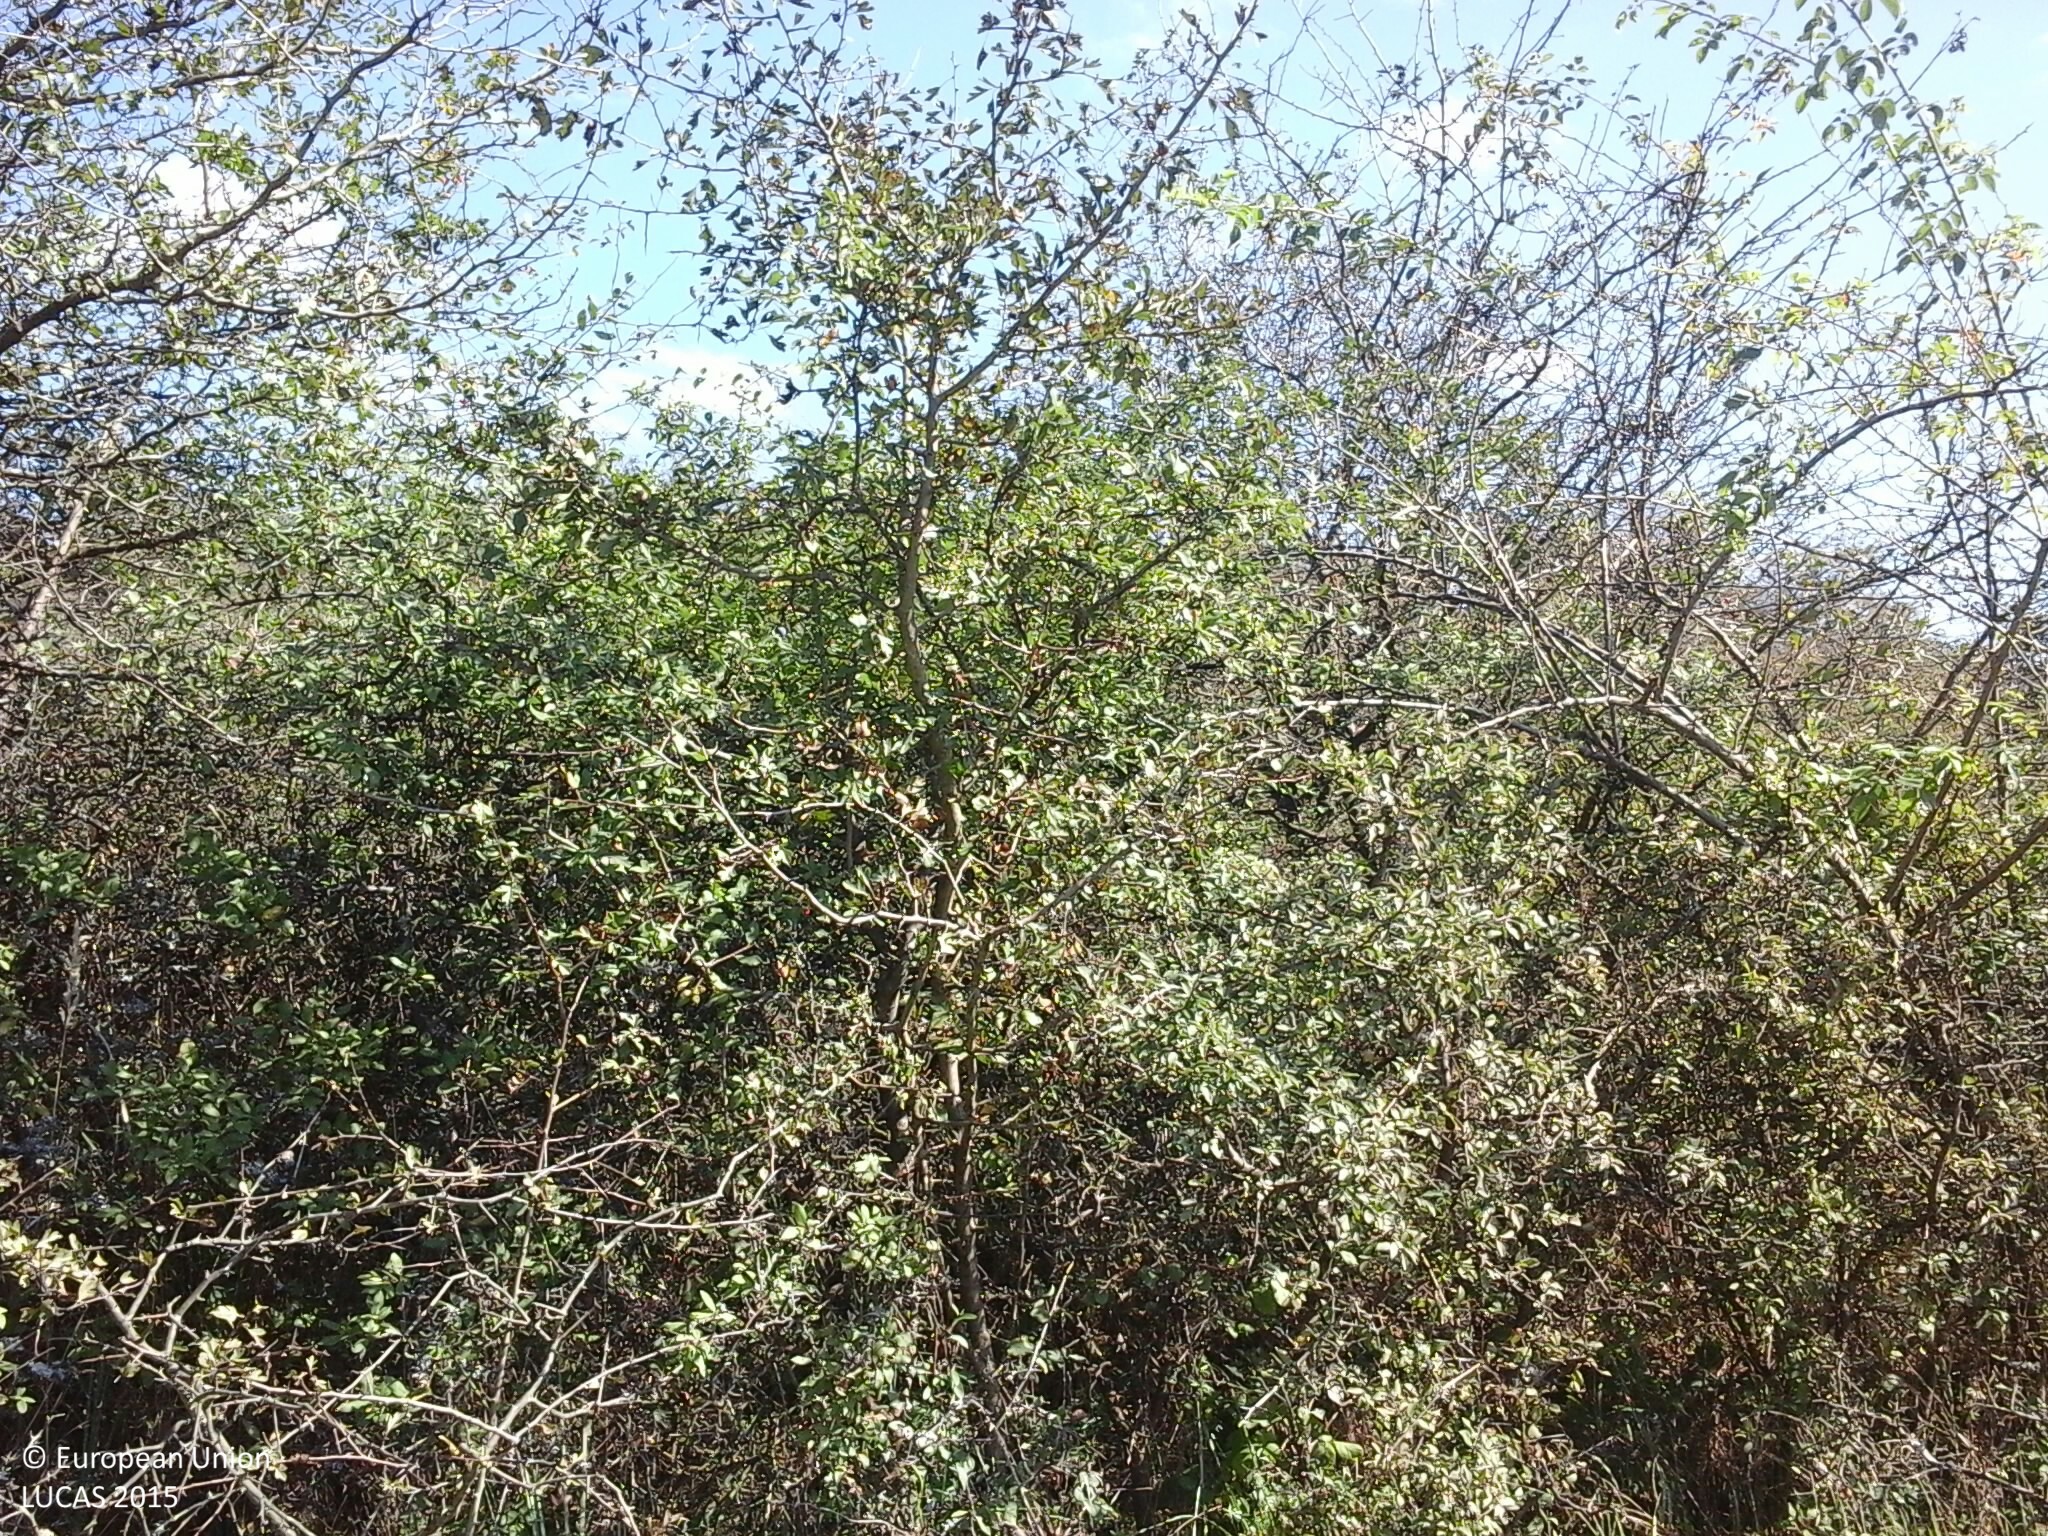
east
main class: Shrubland
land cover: Shrubland with sparse tree cover
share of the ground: > 75 %
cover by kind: shrubs 90 %, broadleaved forest trees 5 %, herbaceous plants 5 %
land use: Agriculture (excluding fallow land and kitchen gardens)
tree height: < 5 m
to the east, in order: Shrubland with sparse tree cover; Grassland with sparse tree/shrub cover; Tracks; Grassland without tree/shrub cover; Broadleaved woodland
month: September
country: HU
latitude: 48.0143
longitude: 19.8805
